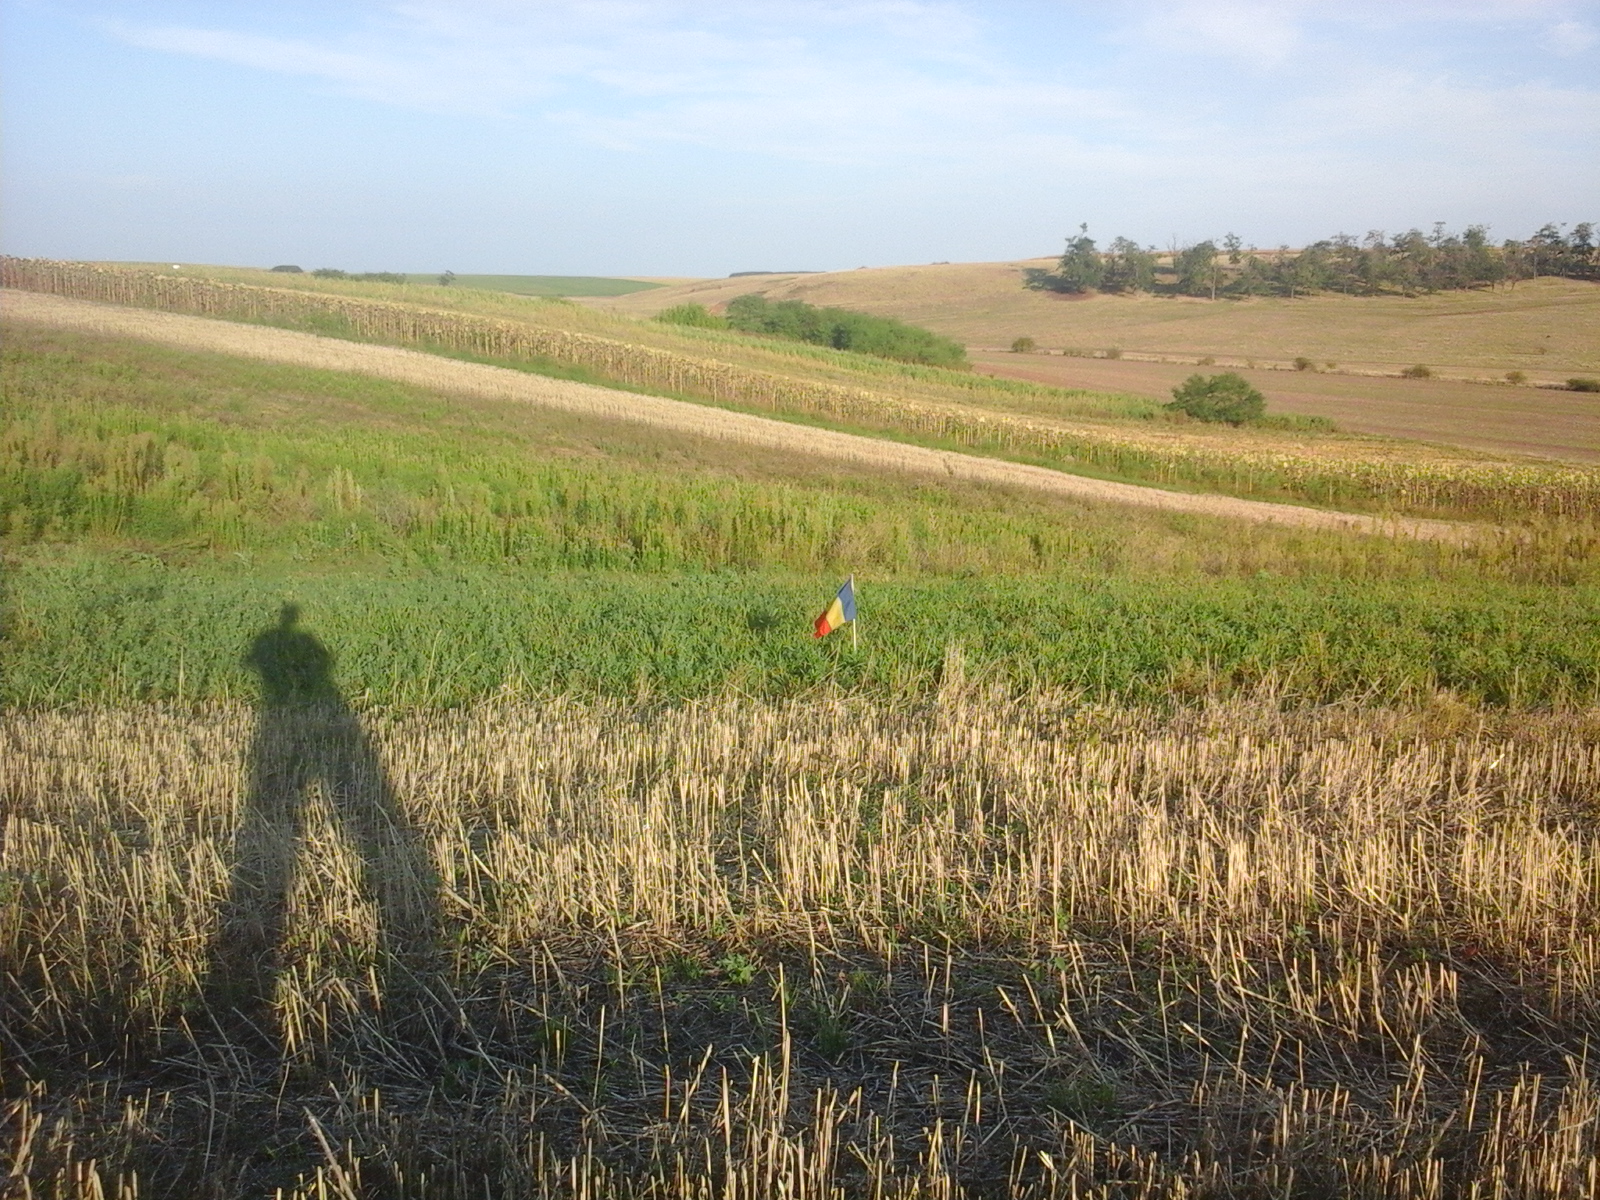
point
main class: Cropland
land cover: Lucerne
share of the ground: > 75 %
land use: Agriculture (excluding fallow land and kitchen gardens)
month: August
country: RO
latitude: 46.0220
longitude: 21.3100
